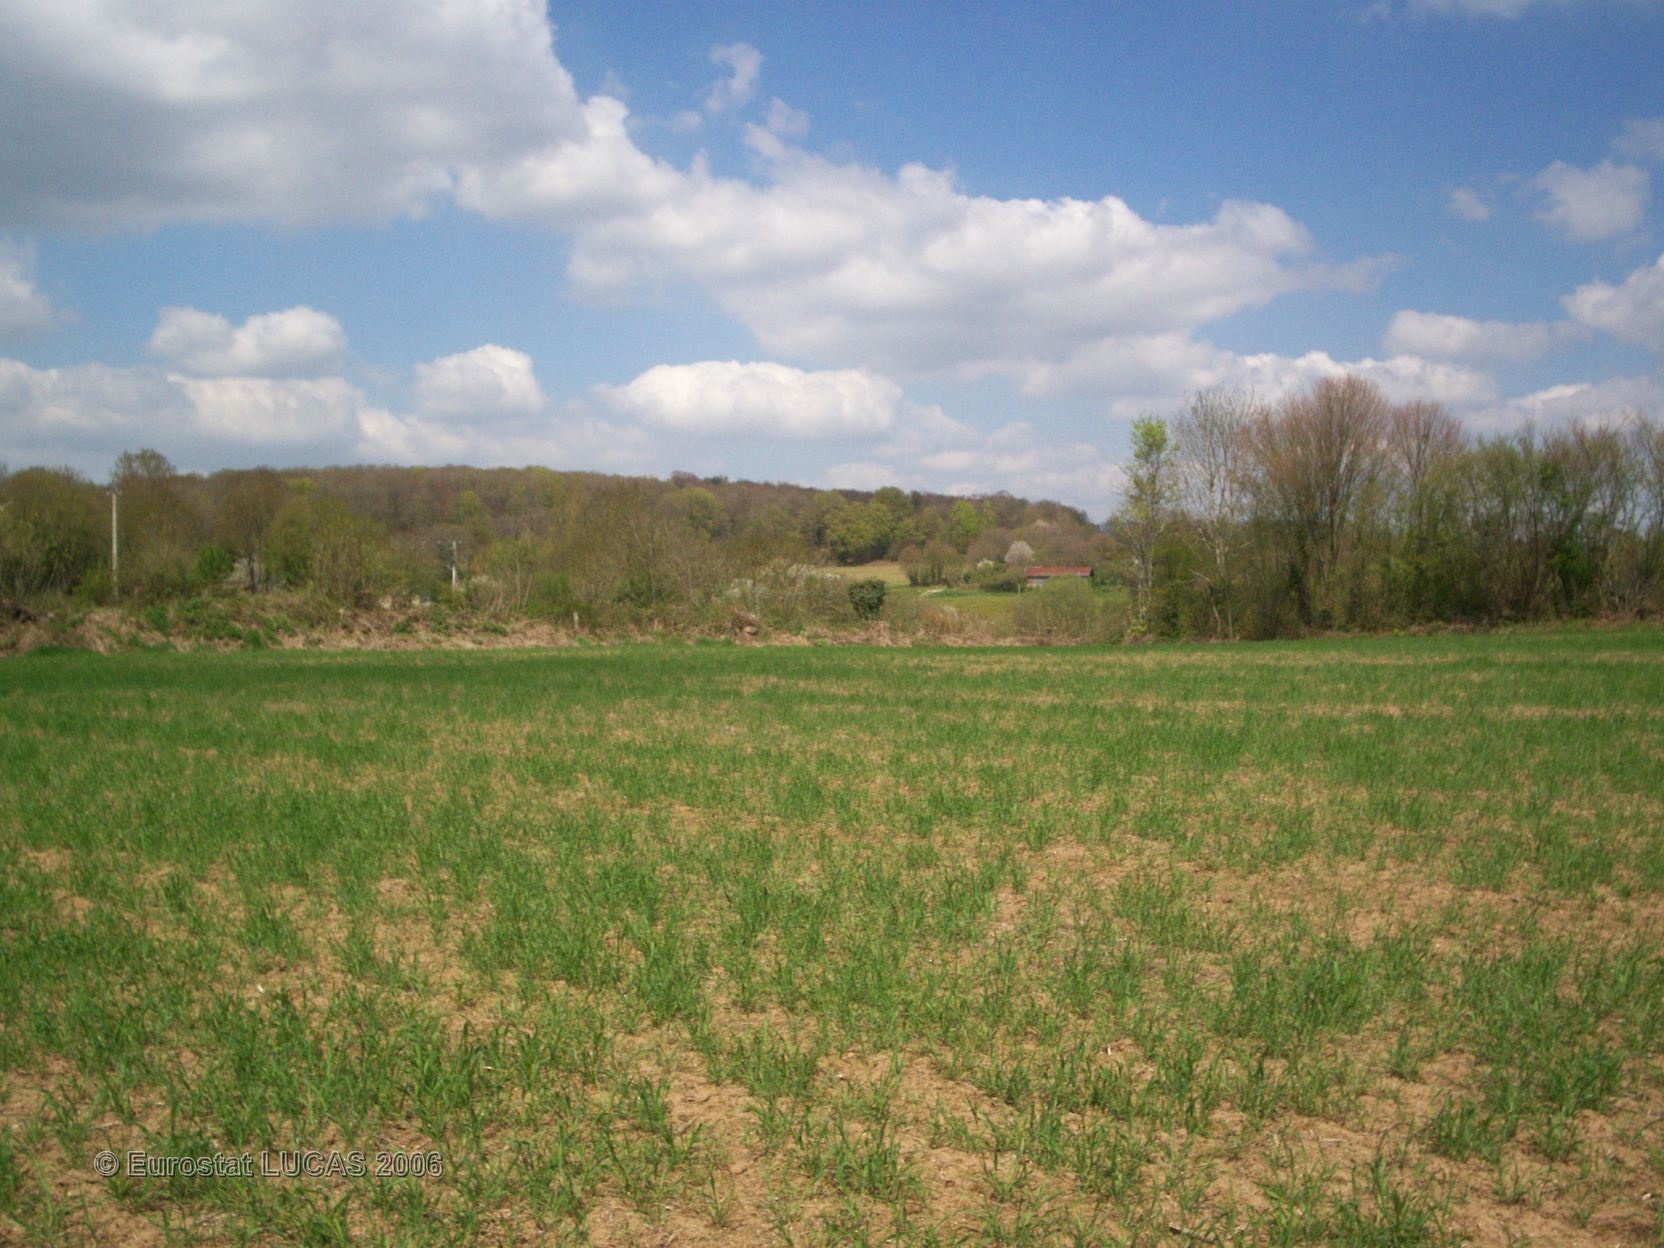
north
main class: Cropland
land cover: Rye
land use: Agriculture (excluding fallow land and kitchen gardens)
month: April
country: FR
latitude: 48.2342
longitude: -0.2501
